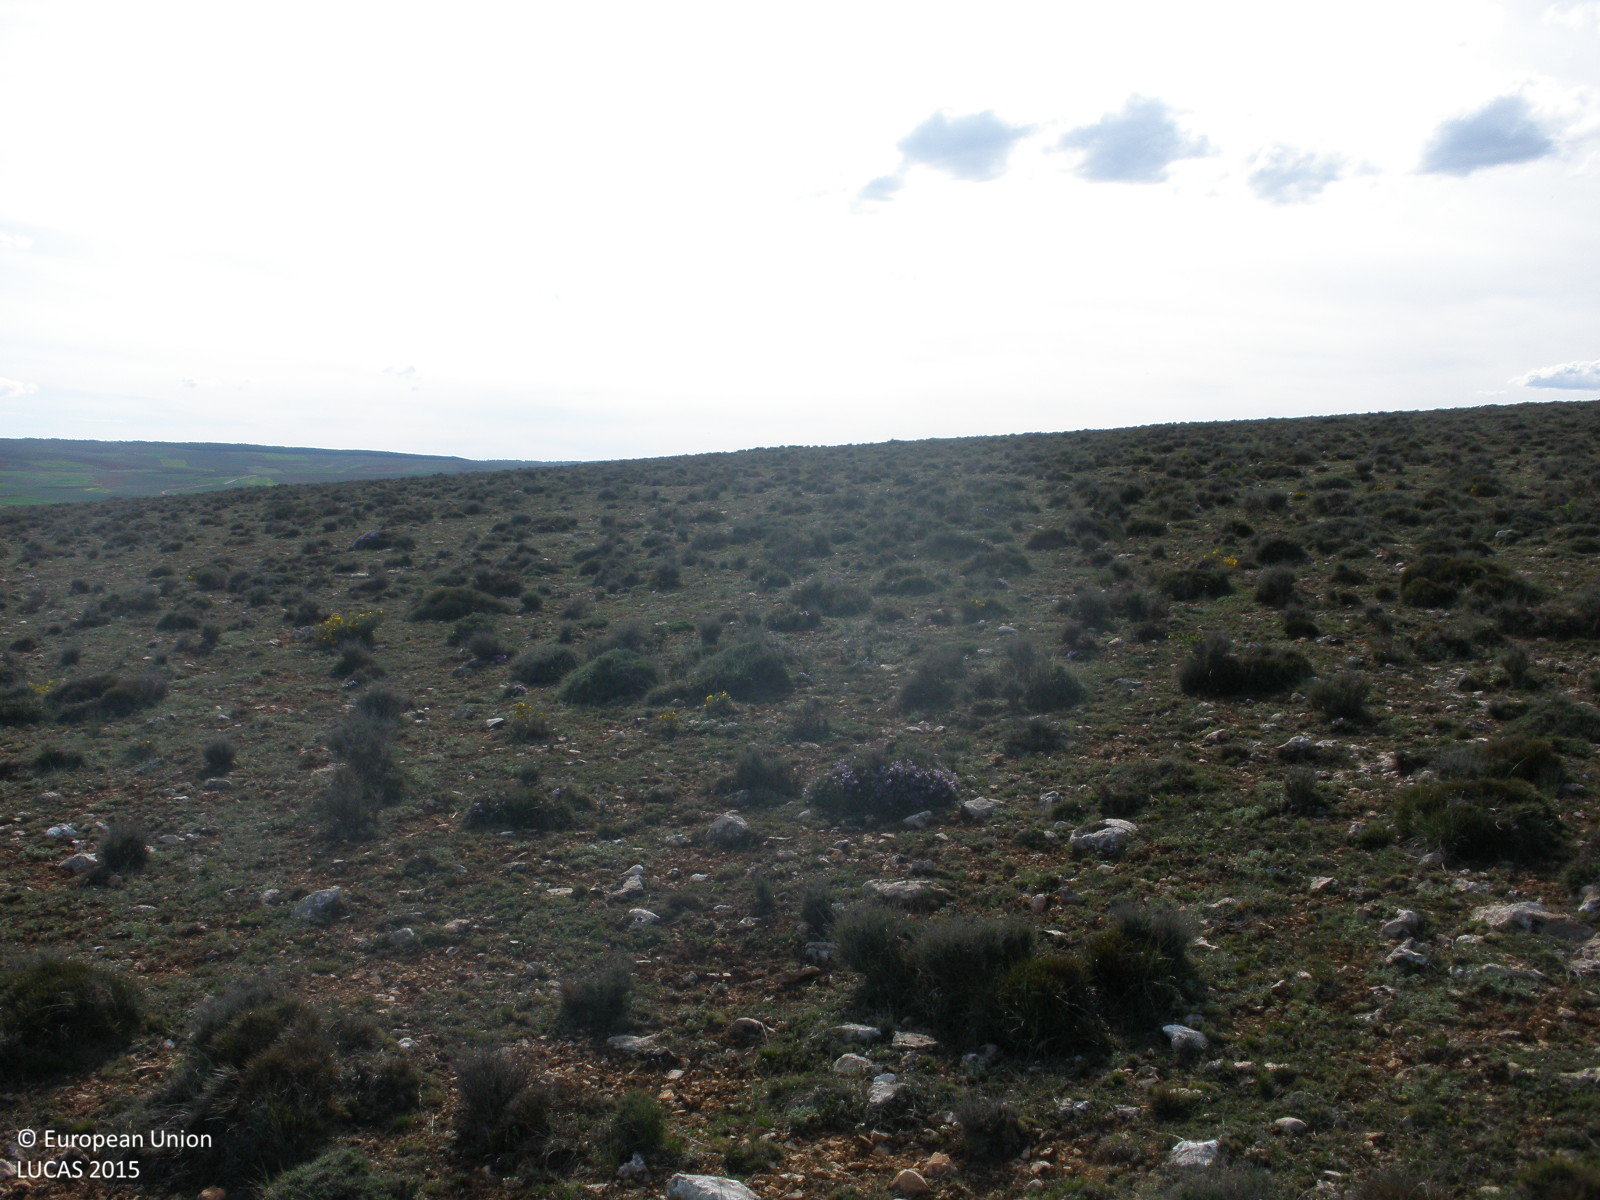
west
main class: Shrubland
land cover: Shrubland without tree cover
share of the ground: 50 - 75 %
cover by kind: shrubs 60 %, herbaceous plants 30 %, consolidated bare surface 10 %
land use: Semi-natural and natural areas not in use
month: May
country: ES
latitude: 40.7525
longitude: -0.8982
